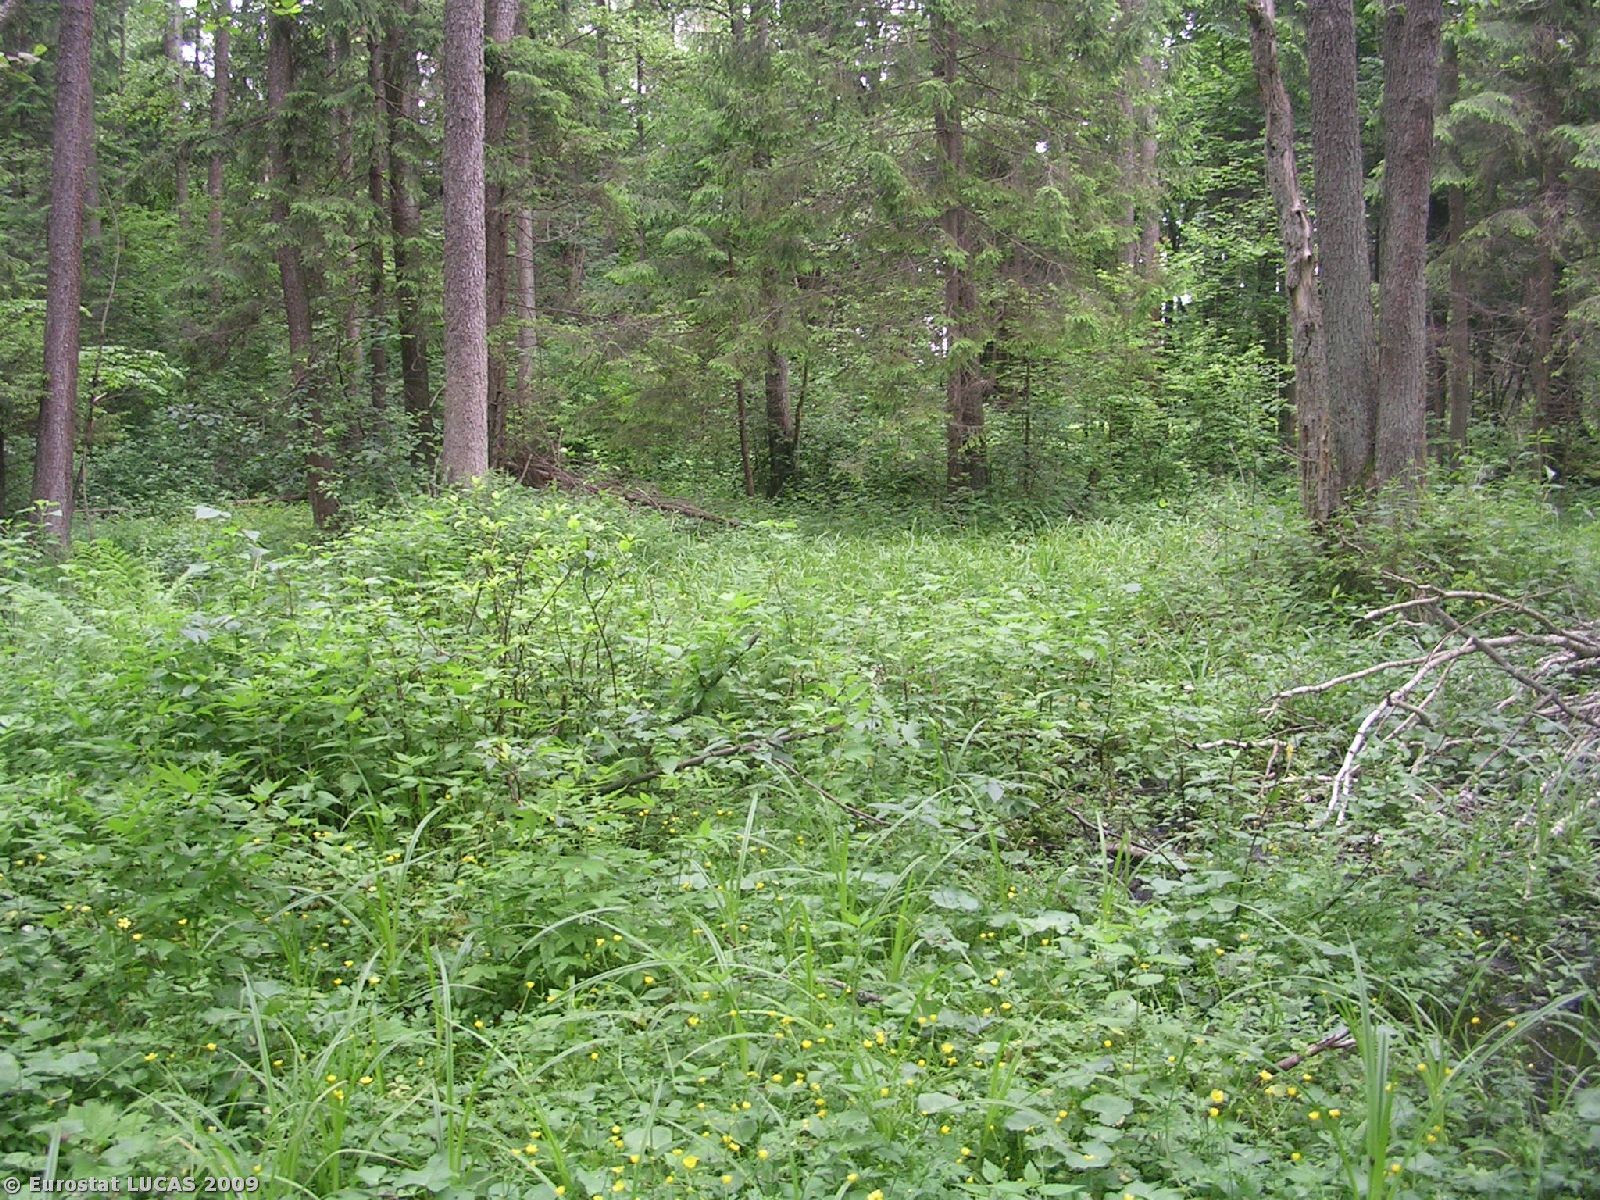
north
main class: Woodland
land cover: Mixed woodland
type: hemiboreal forest and nemoral coniferous forest and mixed broadleaved-coniferous forest
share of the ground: 50 - 75 %
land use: Forestry
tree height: > 5 m
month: June
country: PL
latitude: 53.3936
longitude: 23.2981
